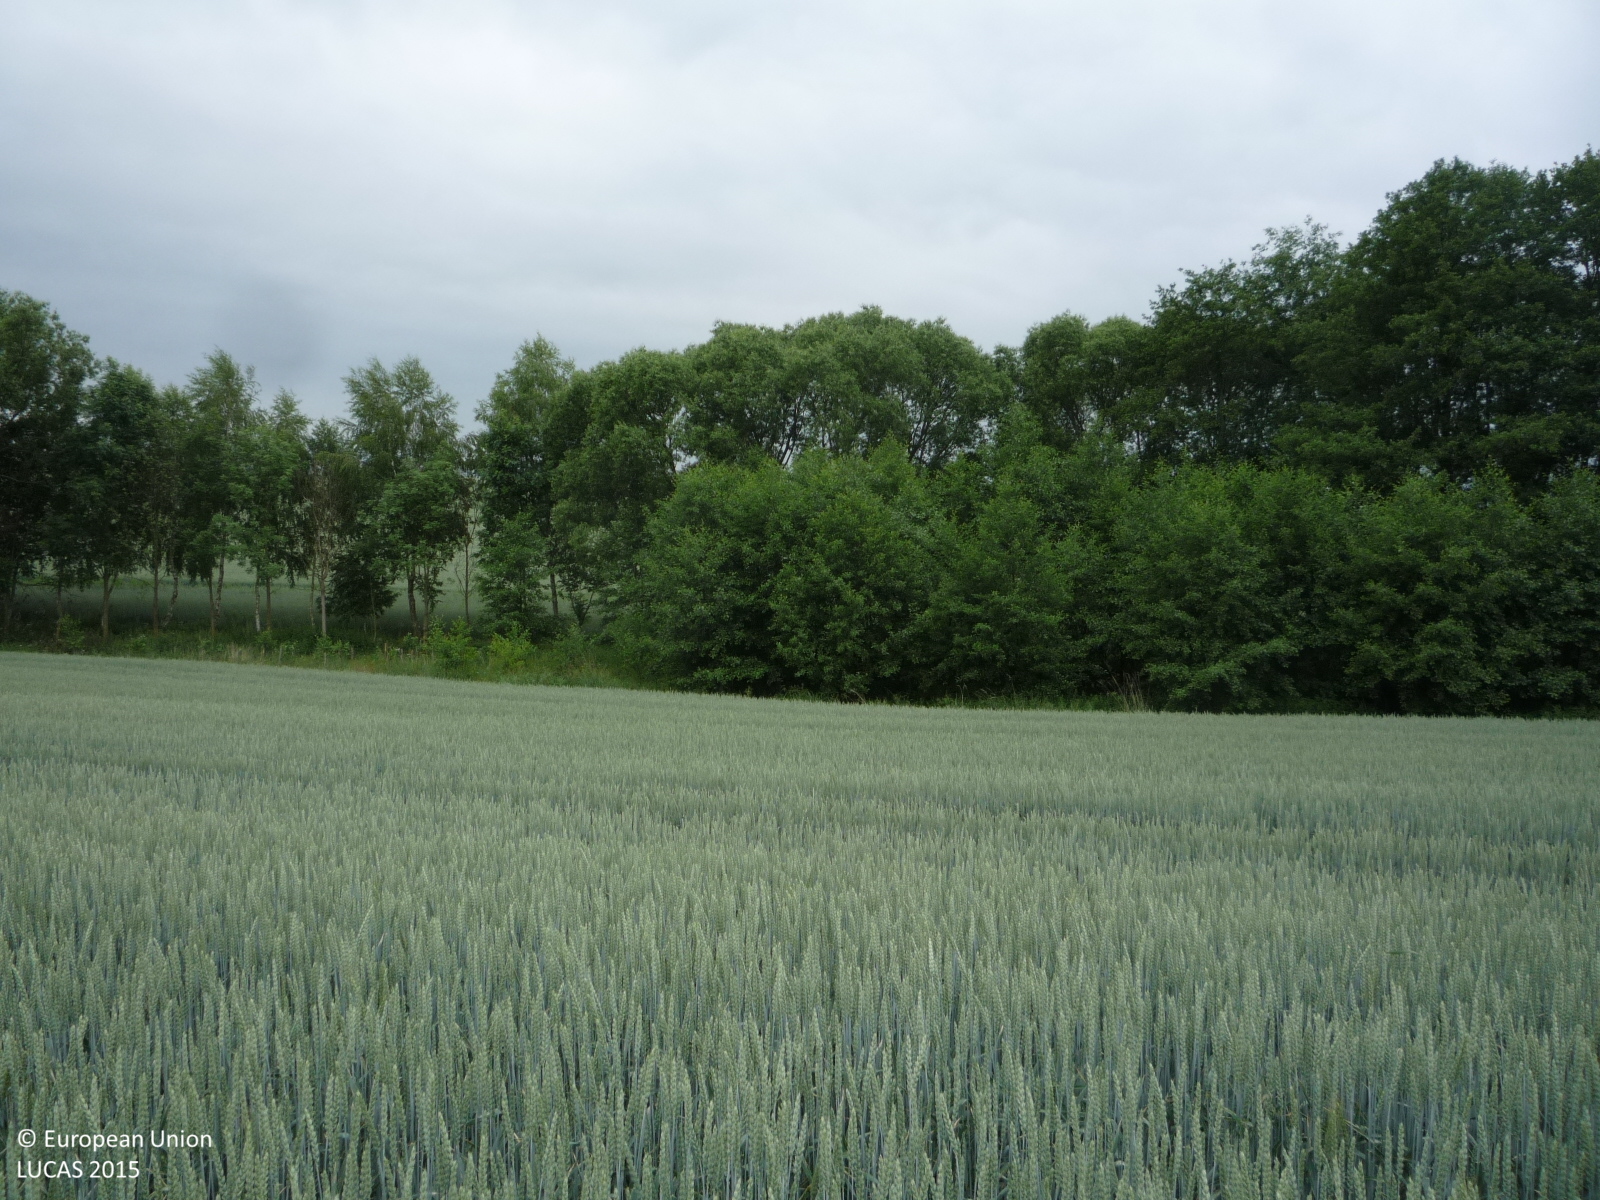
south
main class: Cropland
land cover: Common wheat
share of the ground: > 75 %
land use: Agriculture (excluding fallow land and kitchen gardens)
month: June
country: CZ
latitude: 49.8060
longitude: 14.9631
